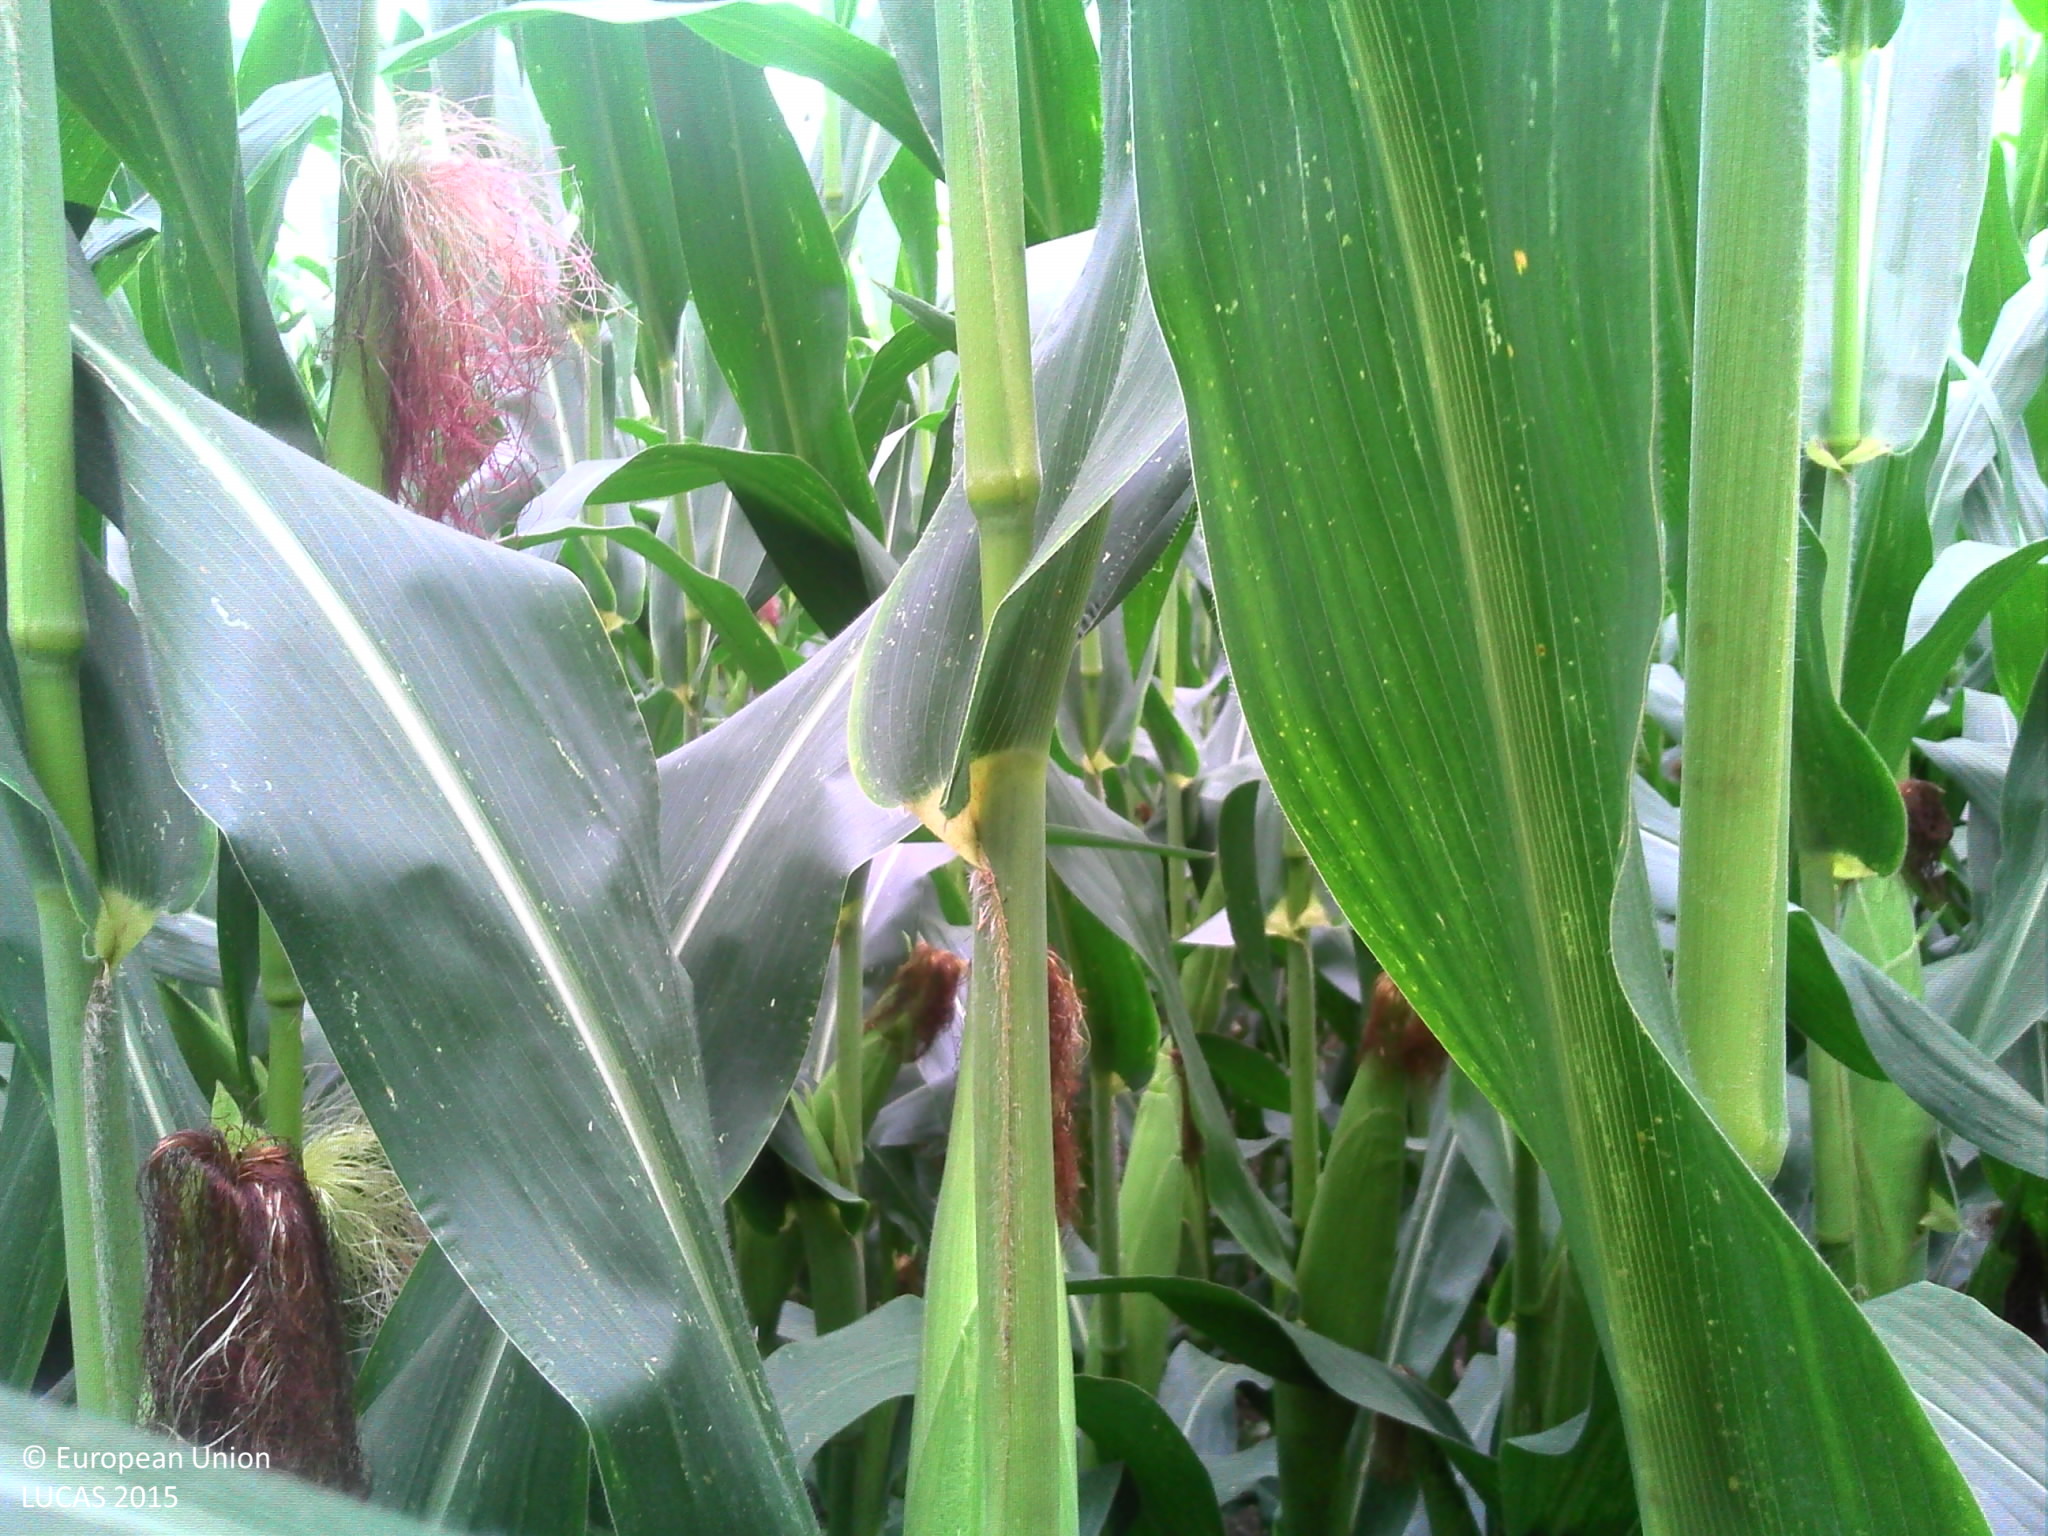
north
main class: Cropland
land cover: Maize
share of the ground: > 75 %
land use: Agriculture (excluding fallow land and kitchen gardens)
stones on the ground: 10 - 25 %
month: July
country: FR
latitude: 47.9362
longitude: 2.0502
